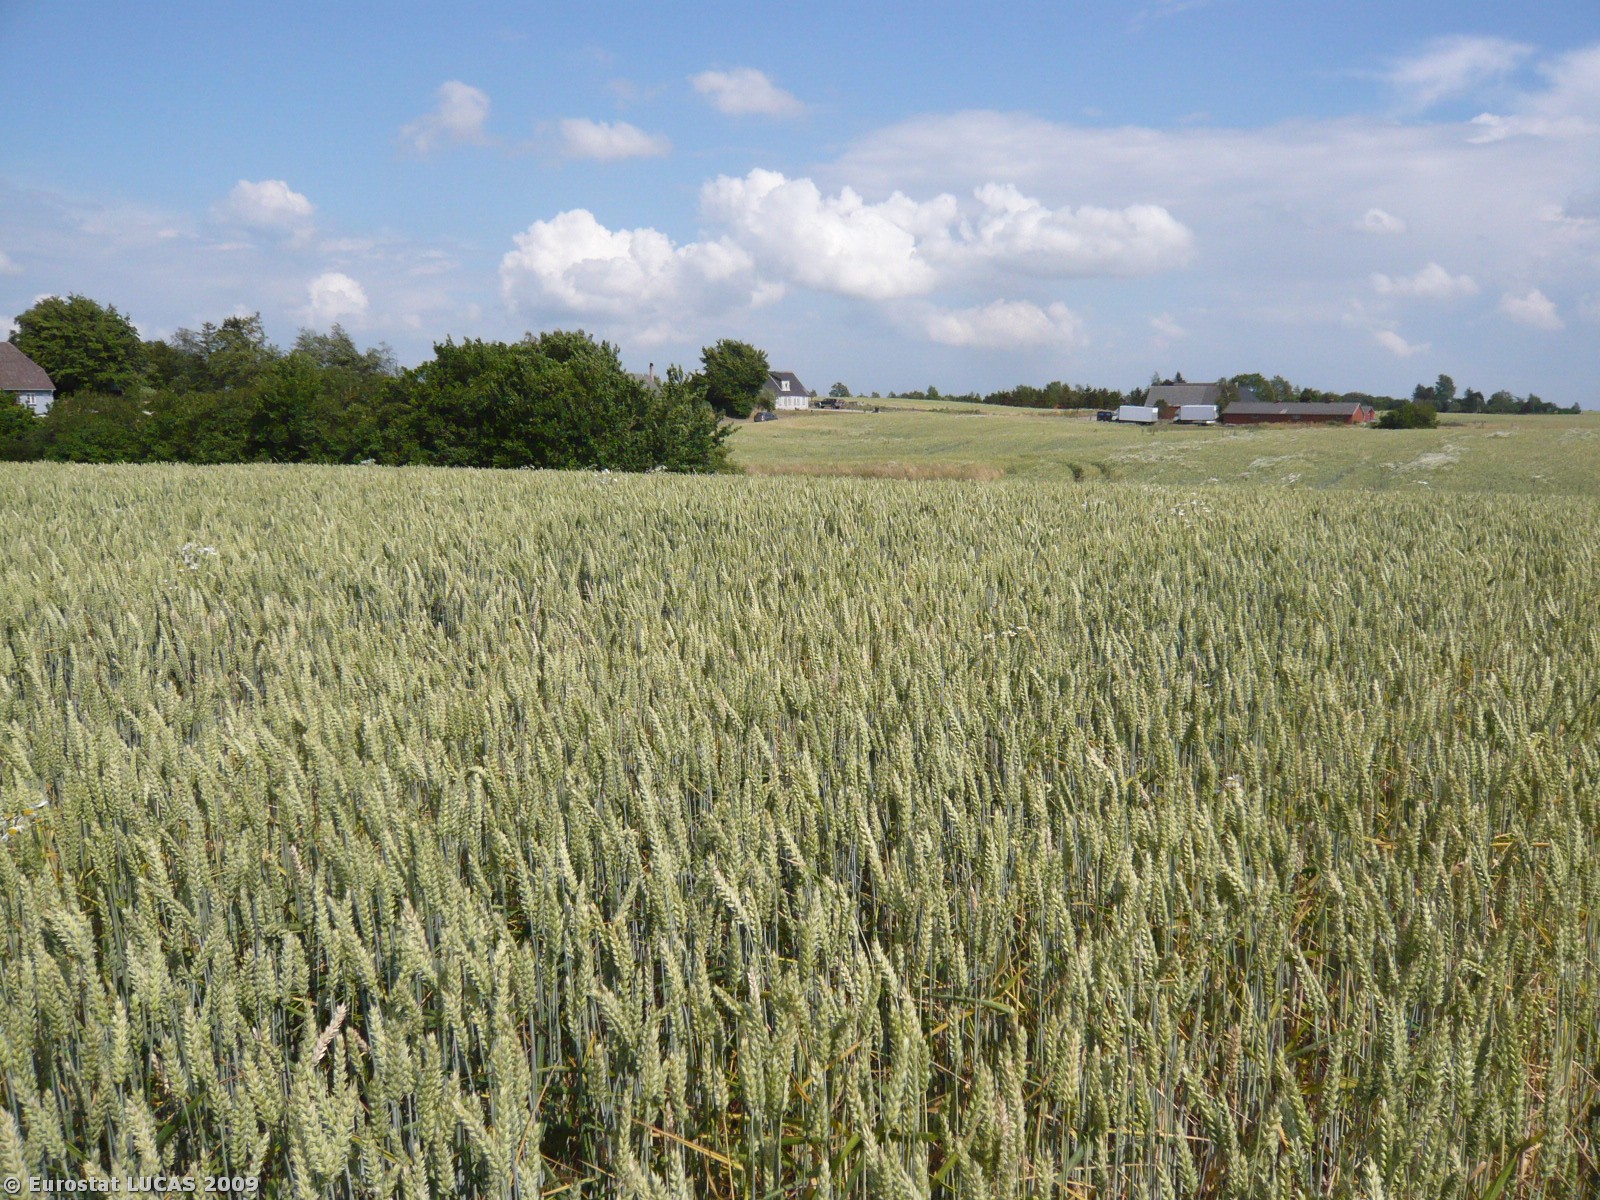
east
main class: Cropland
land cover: Common wheat
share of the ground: > 75 %
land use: Agriculture (excluding fallow land and kitchen gardens)
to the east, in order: Common wheat; Grass margins; Paved roads, cycling and walking lanes; Grassland without tree/shrub cover; Artificial constructions in urban areas
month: July
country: DK
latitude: 55.5046
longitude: 10.1740
